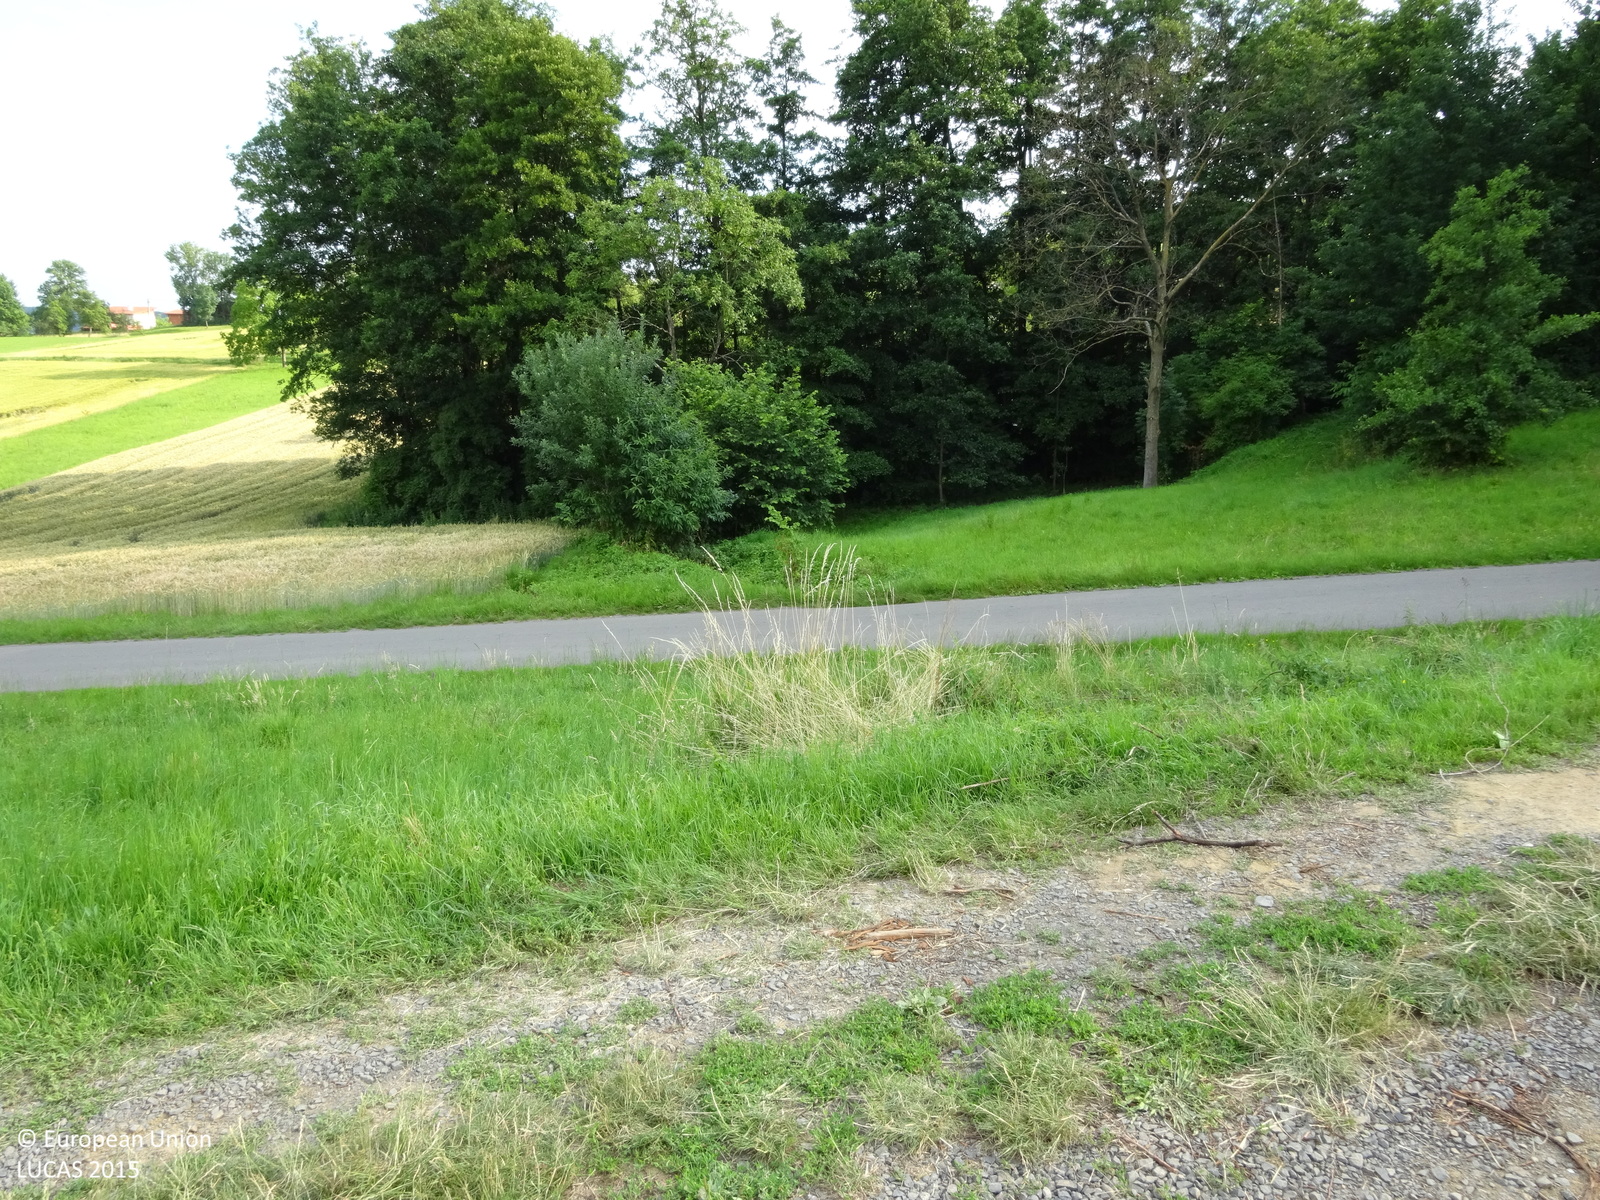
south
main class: Cropland
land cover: Apple fruit
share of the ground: > 75 %
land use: Agriculture (excluding fallow land and kitchen gardens)
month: June
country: AT
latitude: 46.8003
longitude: 15.9358
